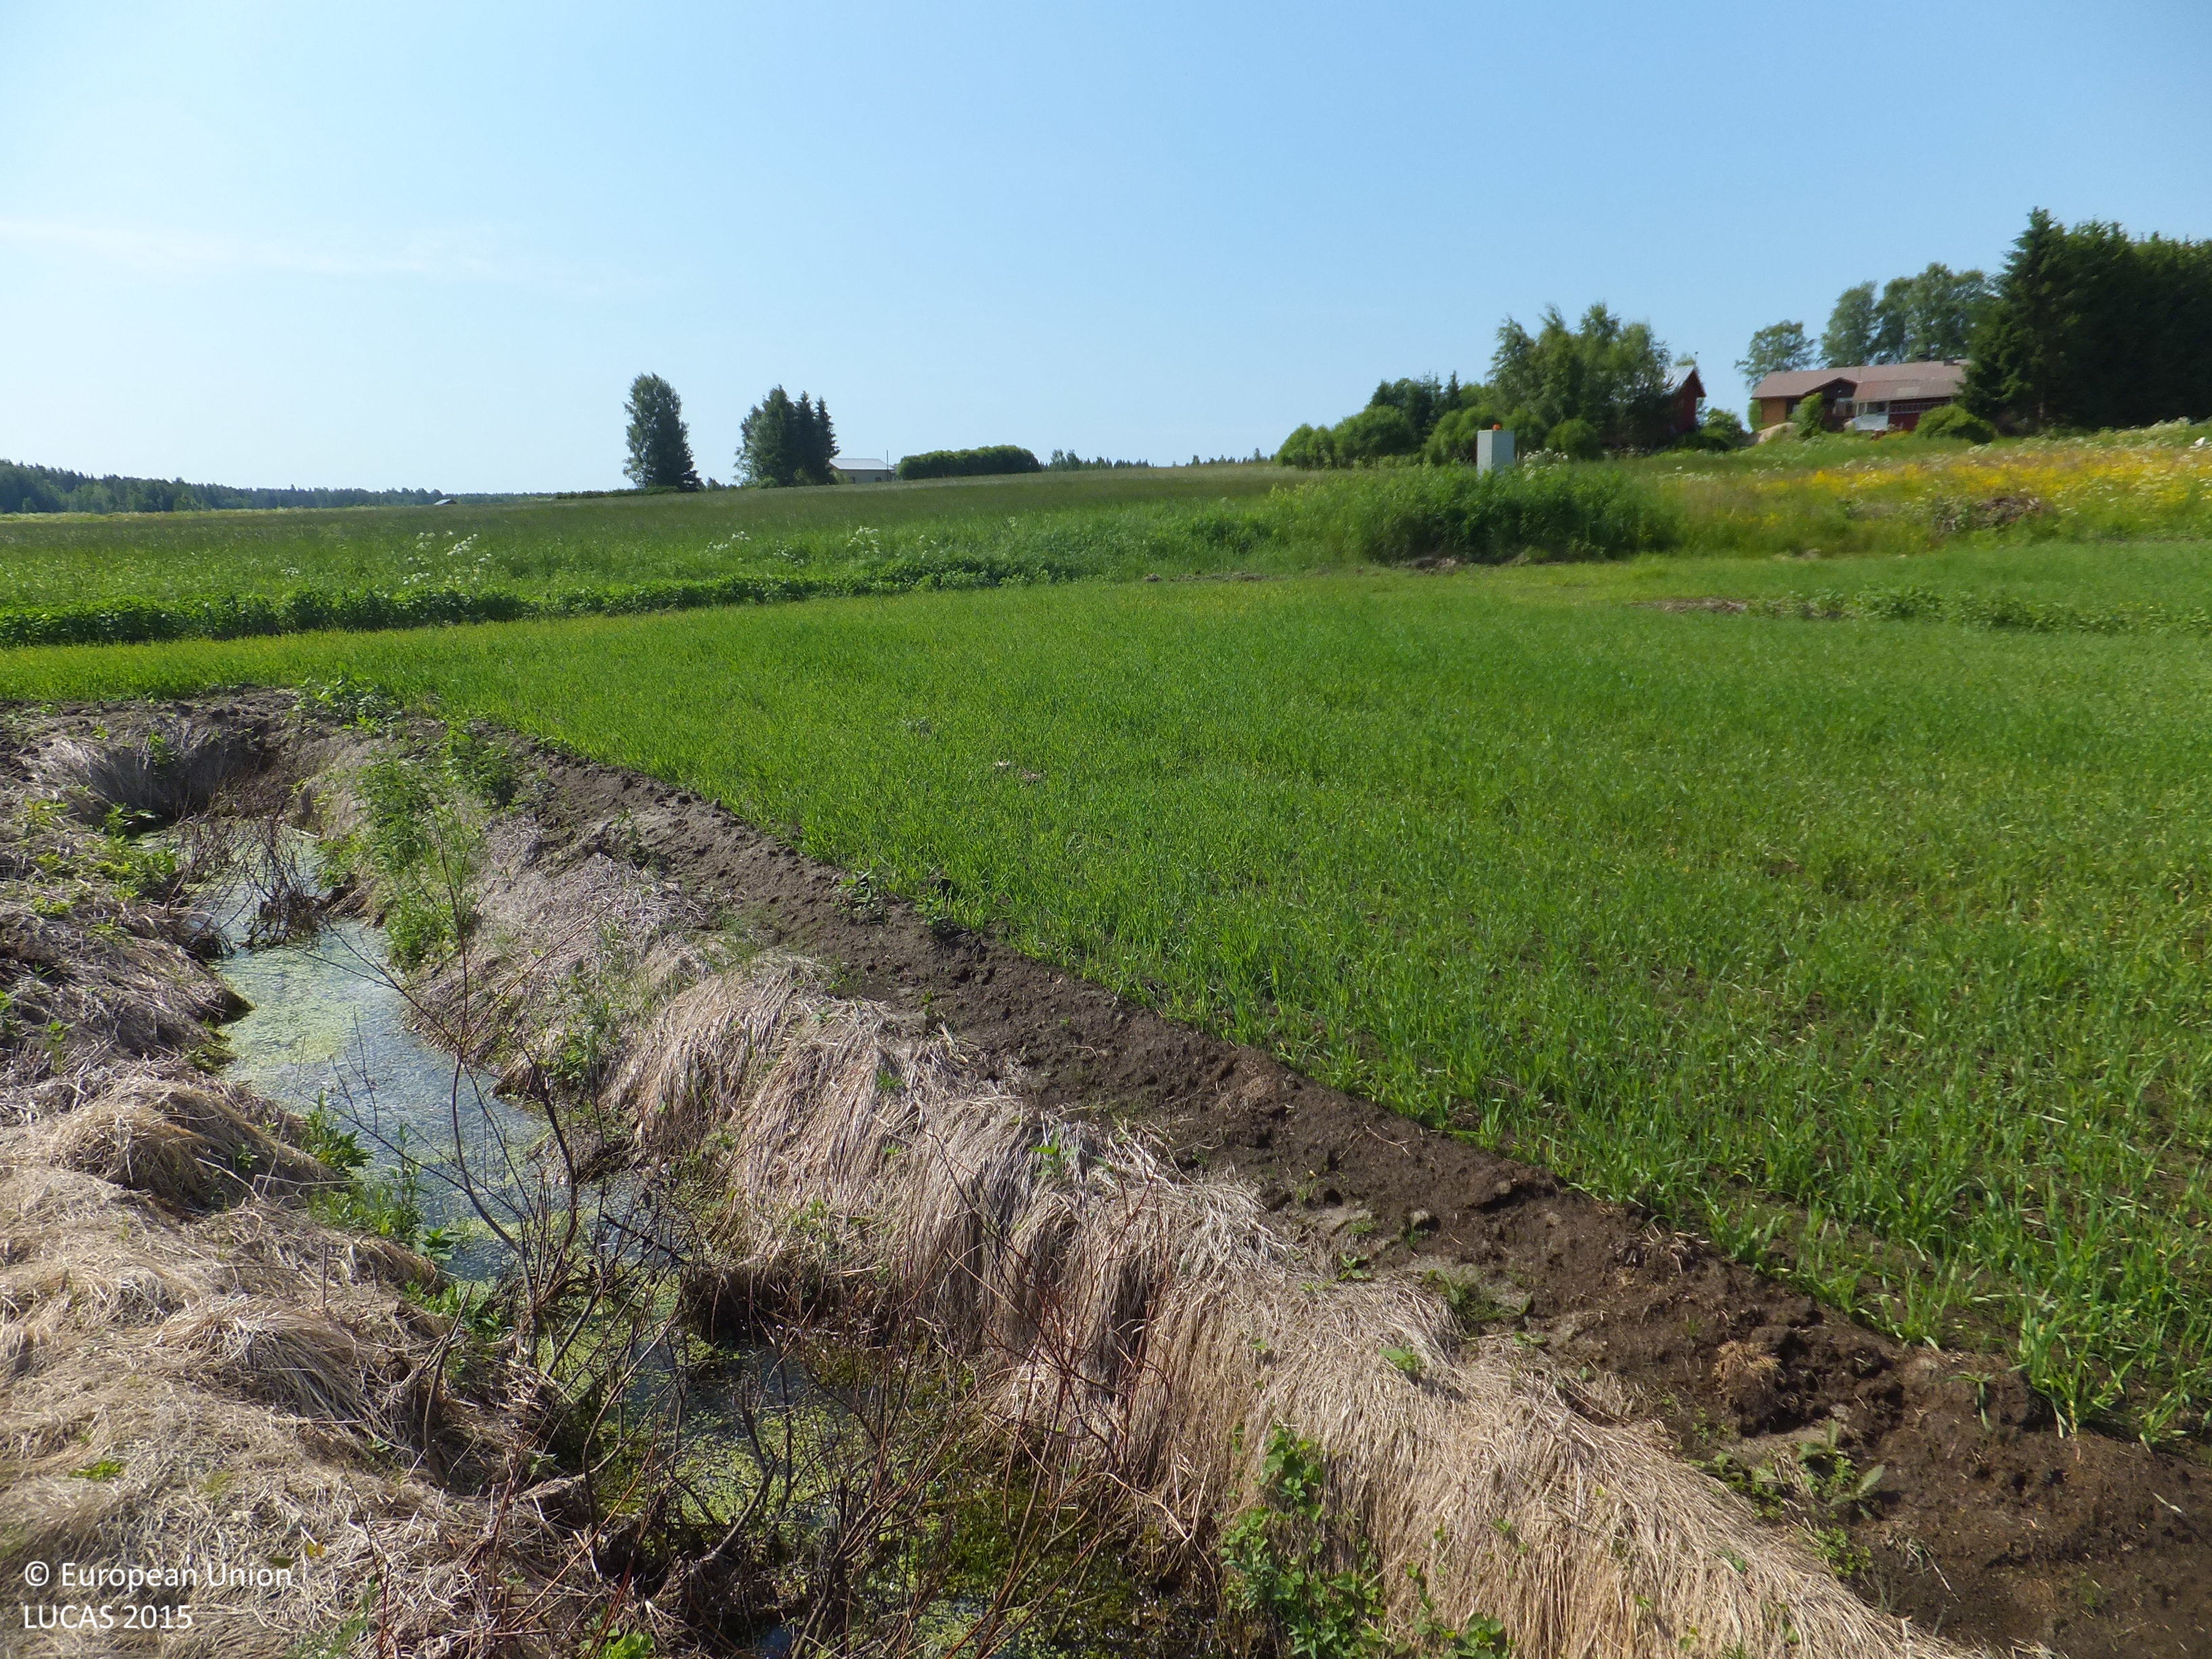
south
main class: Cropland
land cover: Barley
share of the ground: 25 - 50 %
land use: Agriculture (excluding fallow land and kitchen gardens)
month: July
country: FI
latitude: 63.2625
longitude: 23.7554
